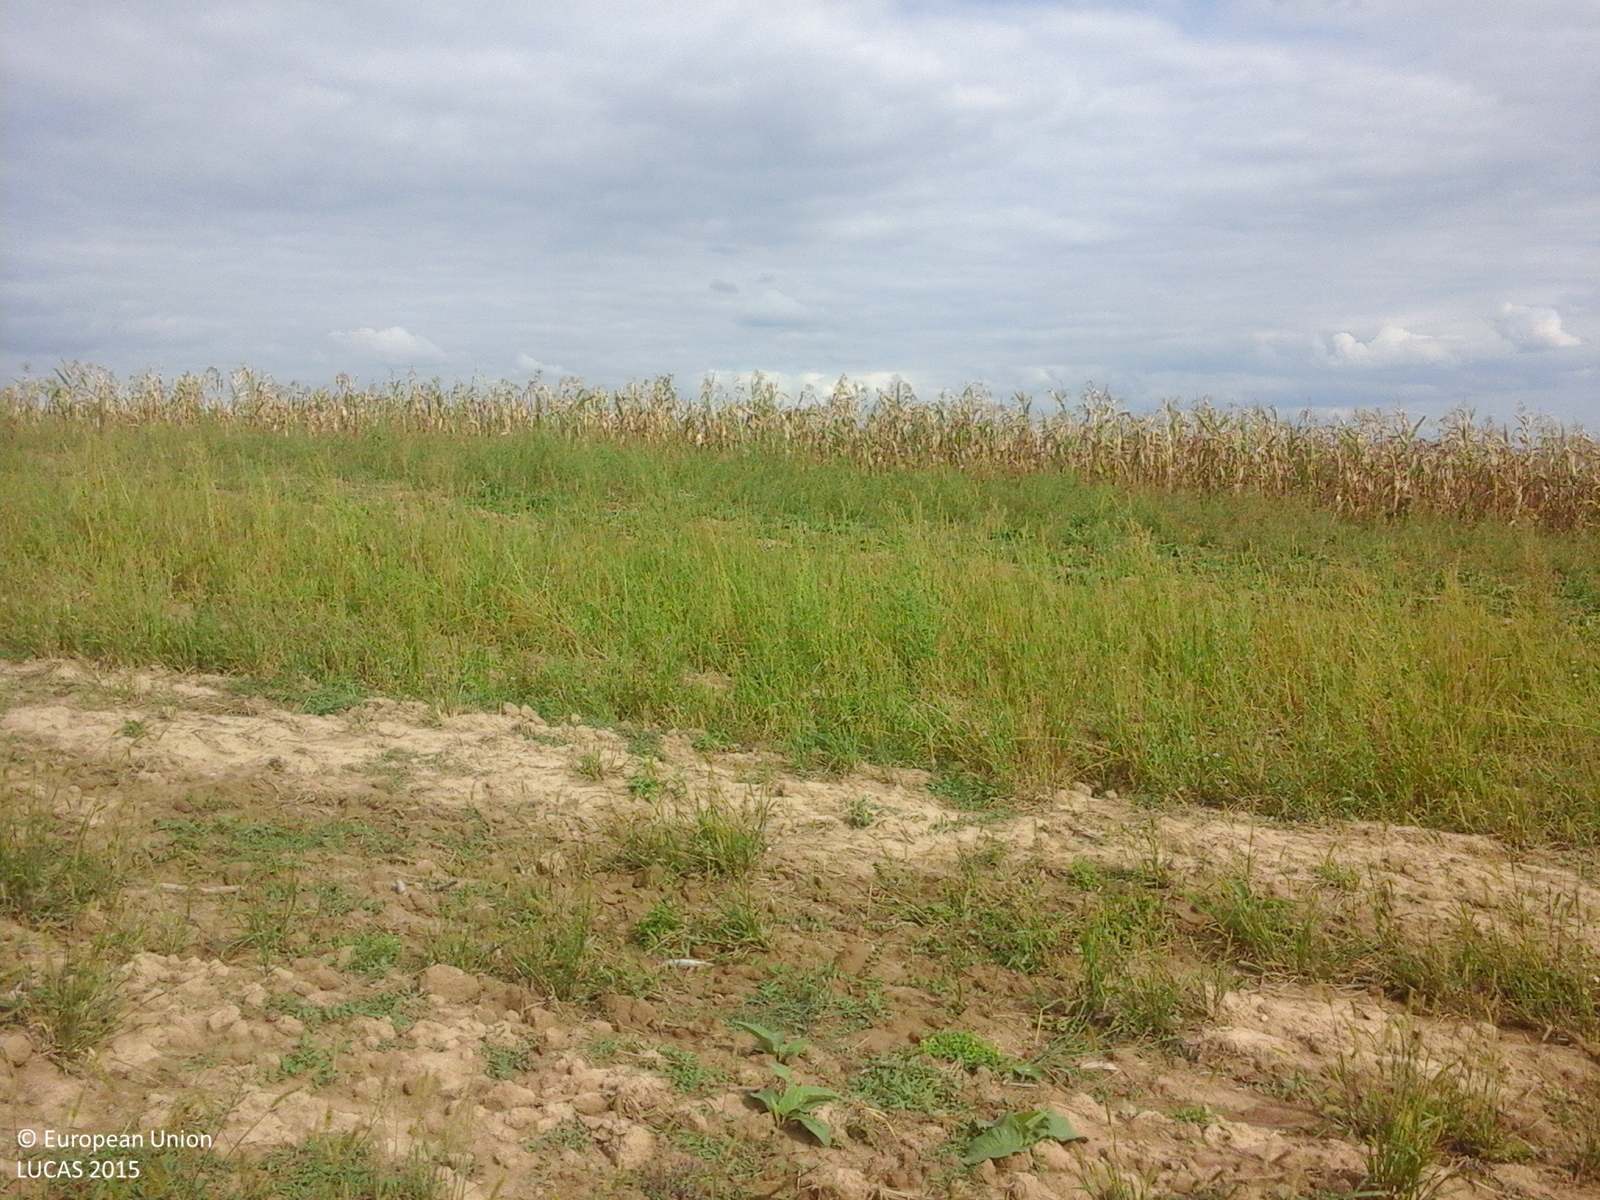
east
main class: Grassland
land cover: Spontaneously vegetated surfaces
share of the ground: > 75 %
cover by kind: herbaceous plants 100 %
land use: Fallow land
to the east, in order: Spontaneously vegetated surfaces; Maize; Common wheat; Grassland without tree/shrub cover; Tracks; Grassland without tree/shrub cover; Sunflower
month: September
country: RO
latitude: 47.4522
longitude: 23.1313
